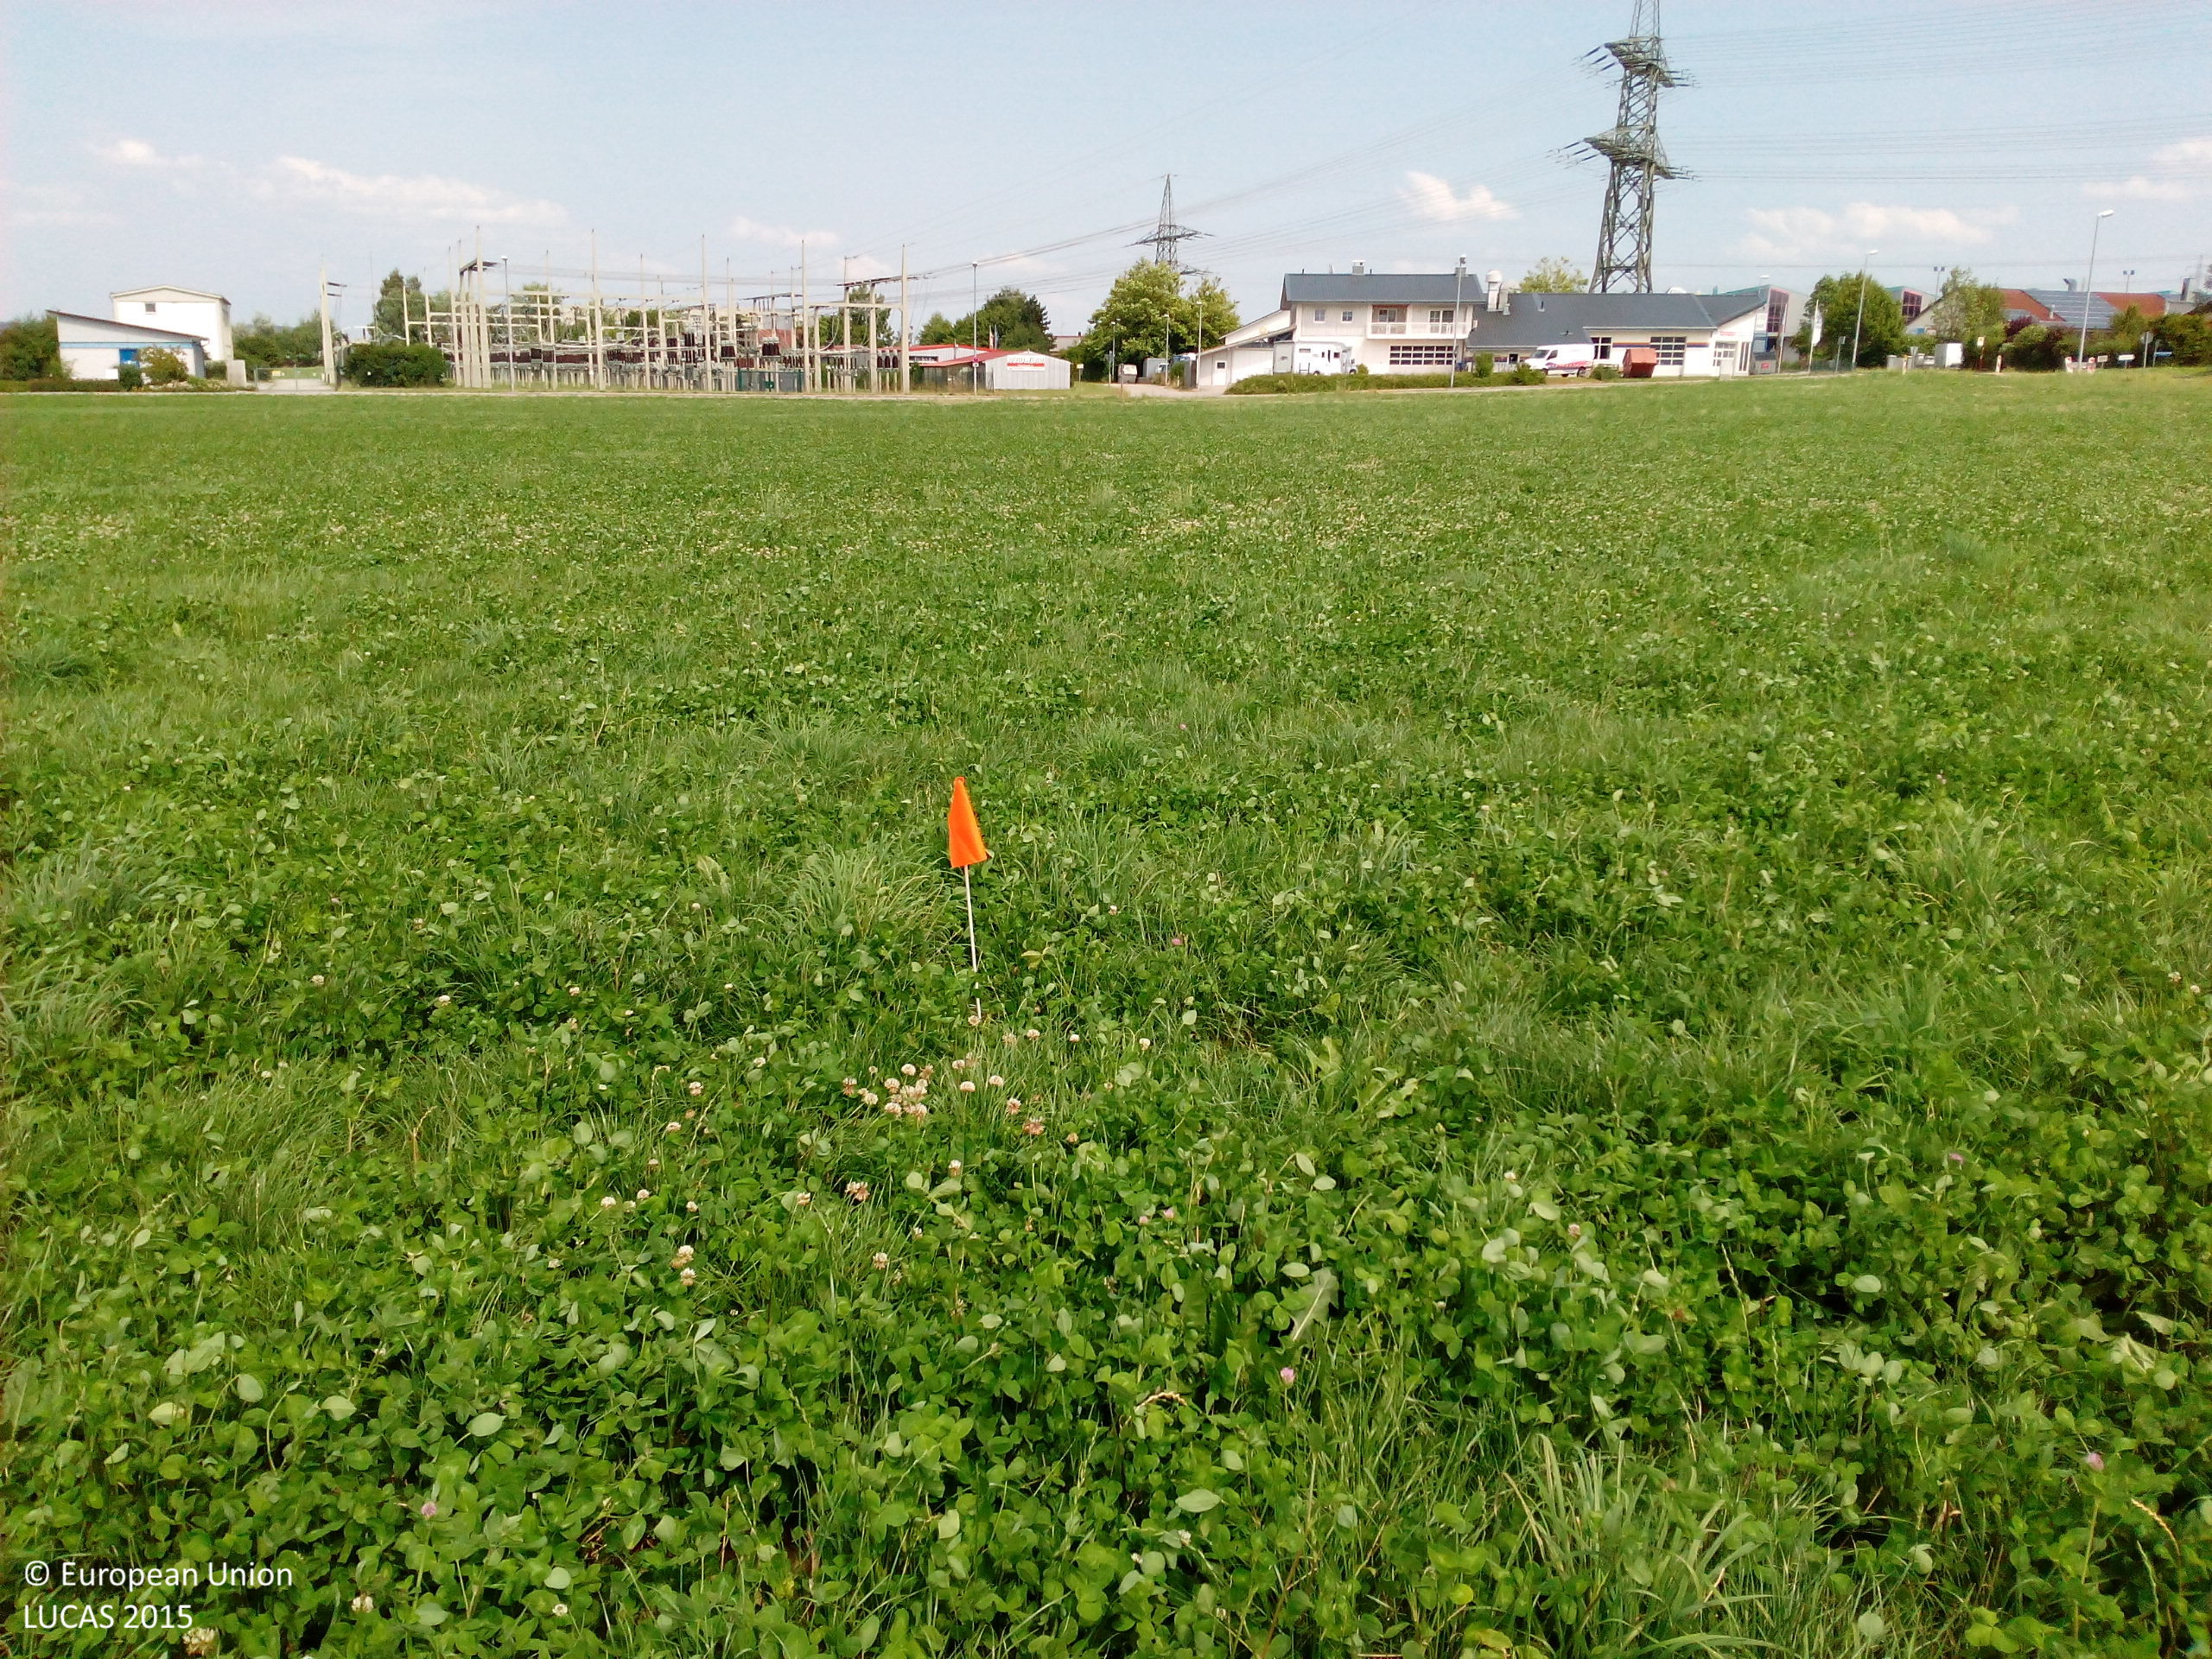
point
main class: Cropland
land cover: Clovers
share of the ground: > 75 %
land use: Agriculture (excluding fallow land and kitchen gardens)
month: July
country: DE
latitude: 48.4187
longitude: 12.9313
